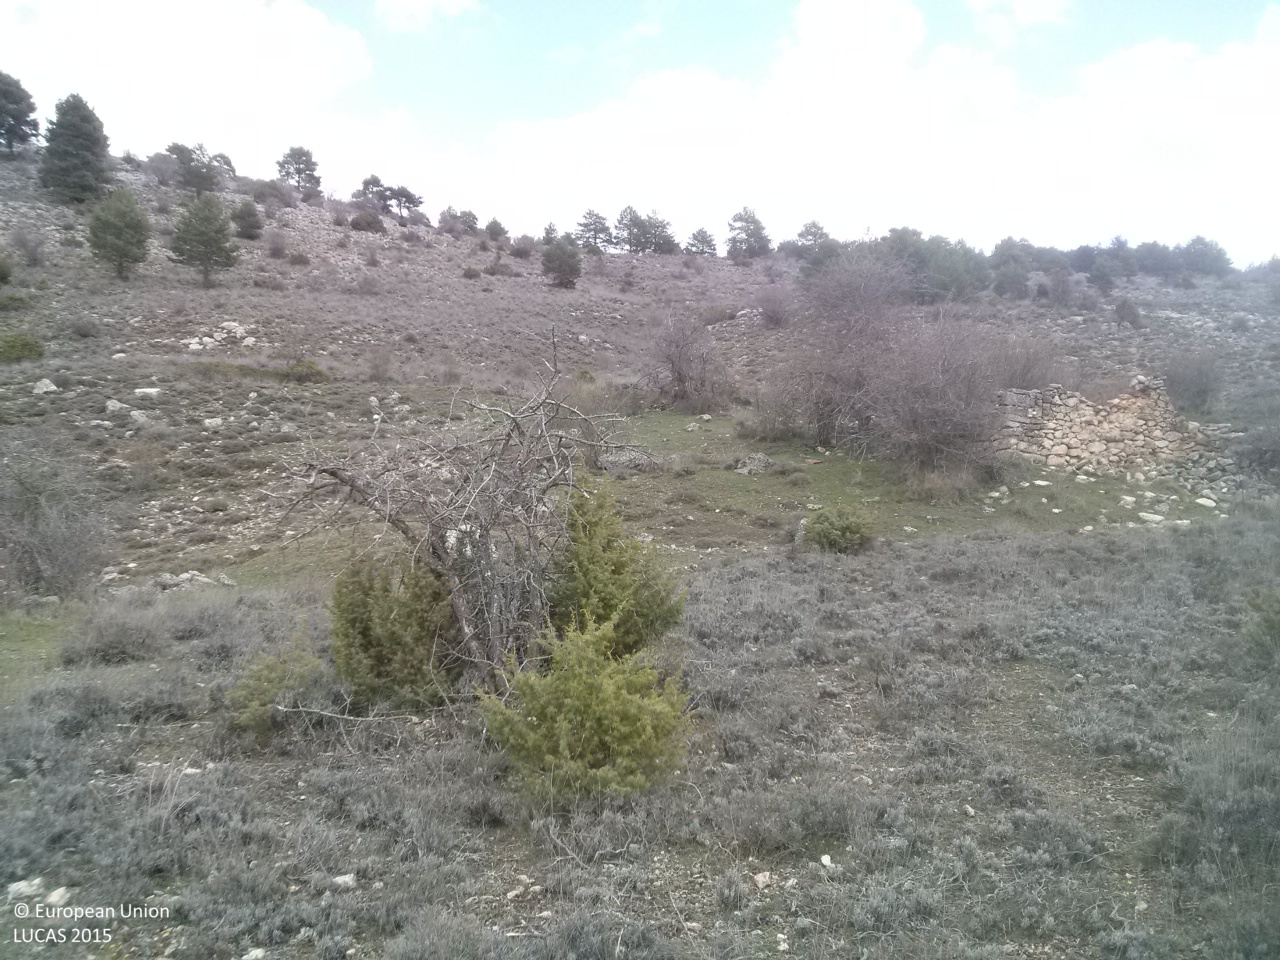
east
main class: Shrubland
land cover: Shrubland without tree cover
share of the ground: 25 - 50 %
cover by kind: shrubs 60 %, herbaceous plants 40 %
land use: Agriculture (excluding fallow land and kitchen gardens)
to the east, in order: Shrubland without tree cover; Dry stone walls; Shrubland without tree cover; Pine dominated coniferous woodland; Shrubland without tree cover; Single bushes/trees; Shrubland without tree cover; Shrubland with sparse tree cover; Shrubland without tree cover; Single bushes/trees
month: April
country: ES
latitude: 40.3681
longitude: -1.8523
